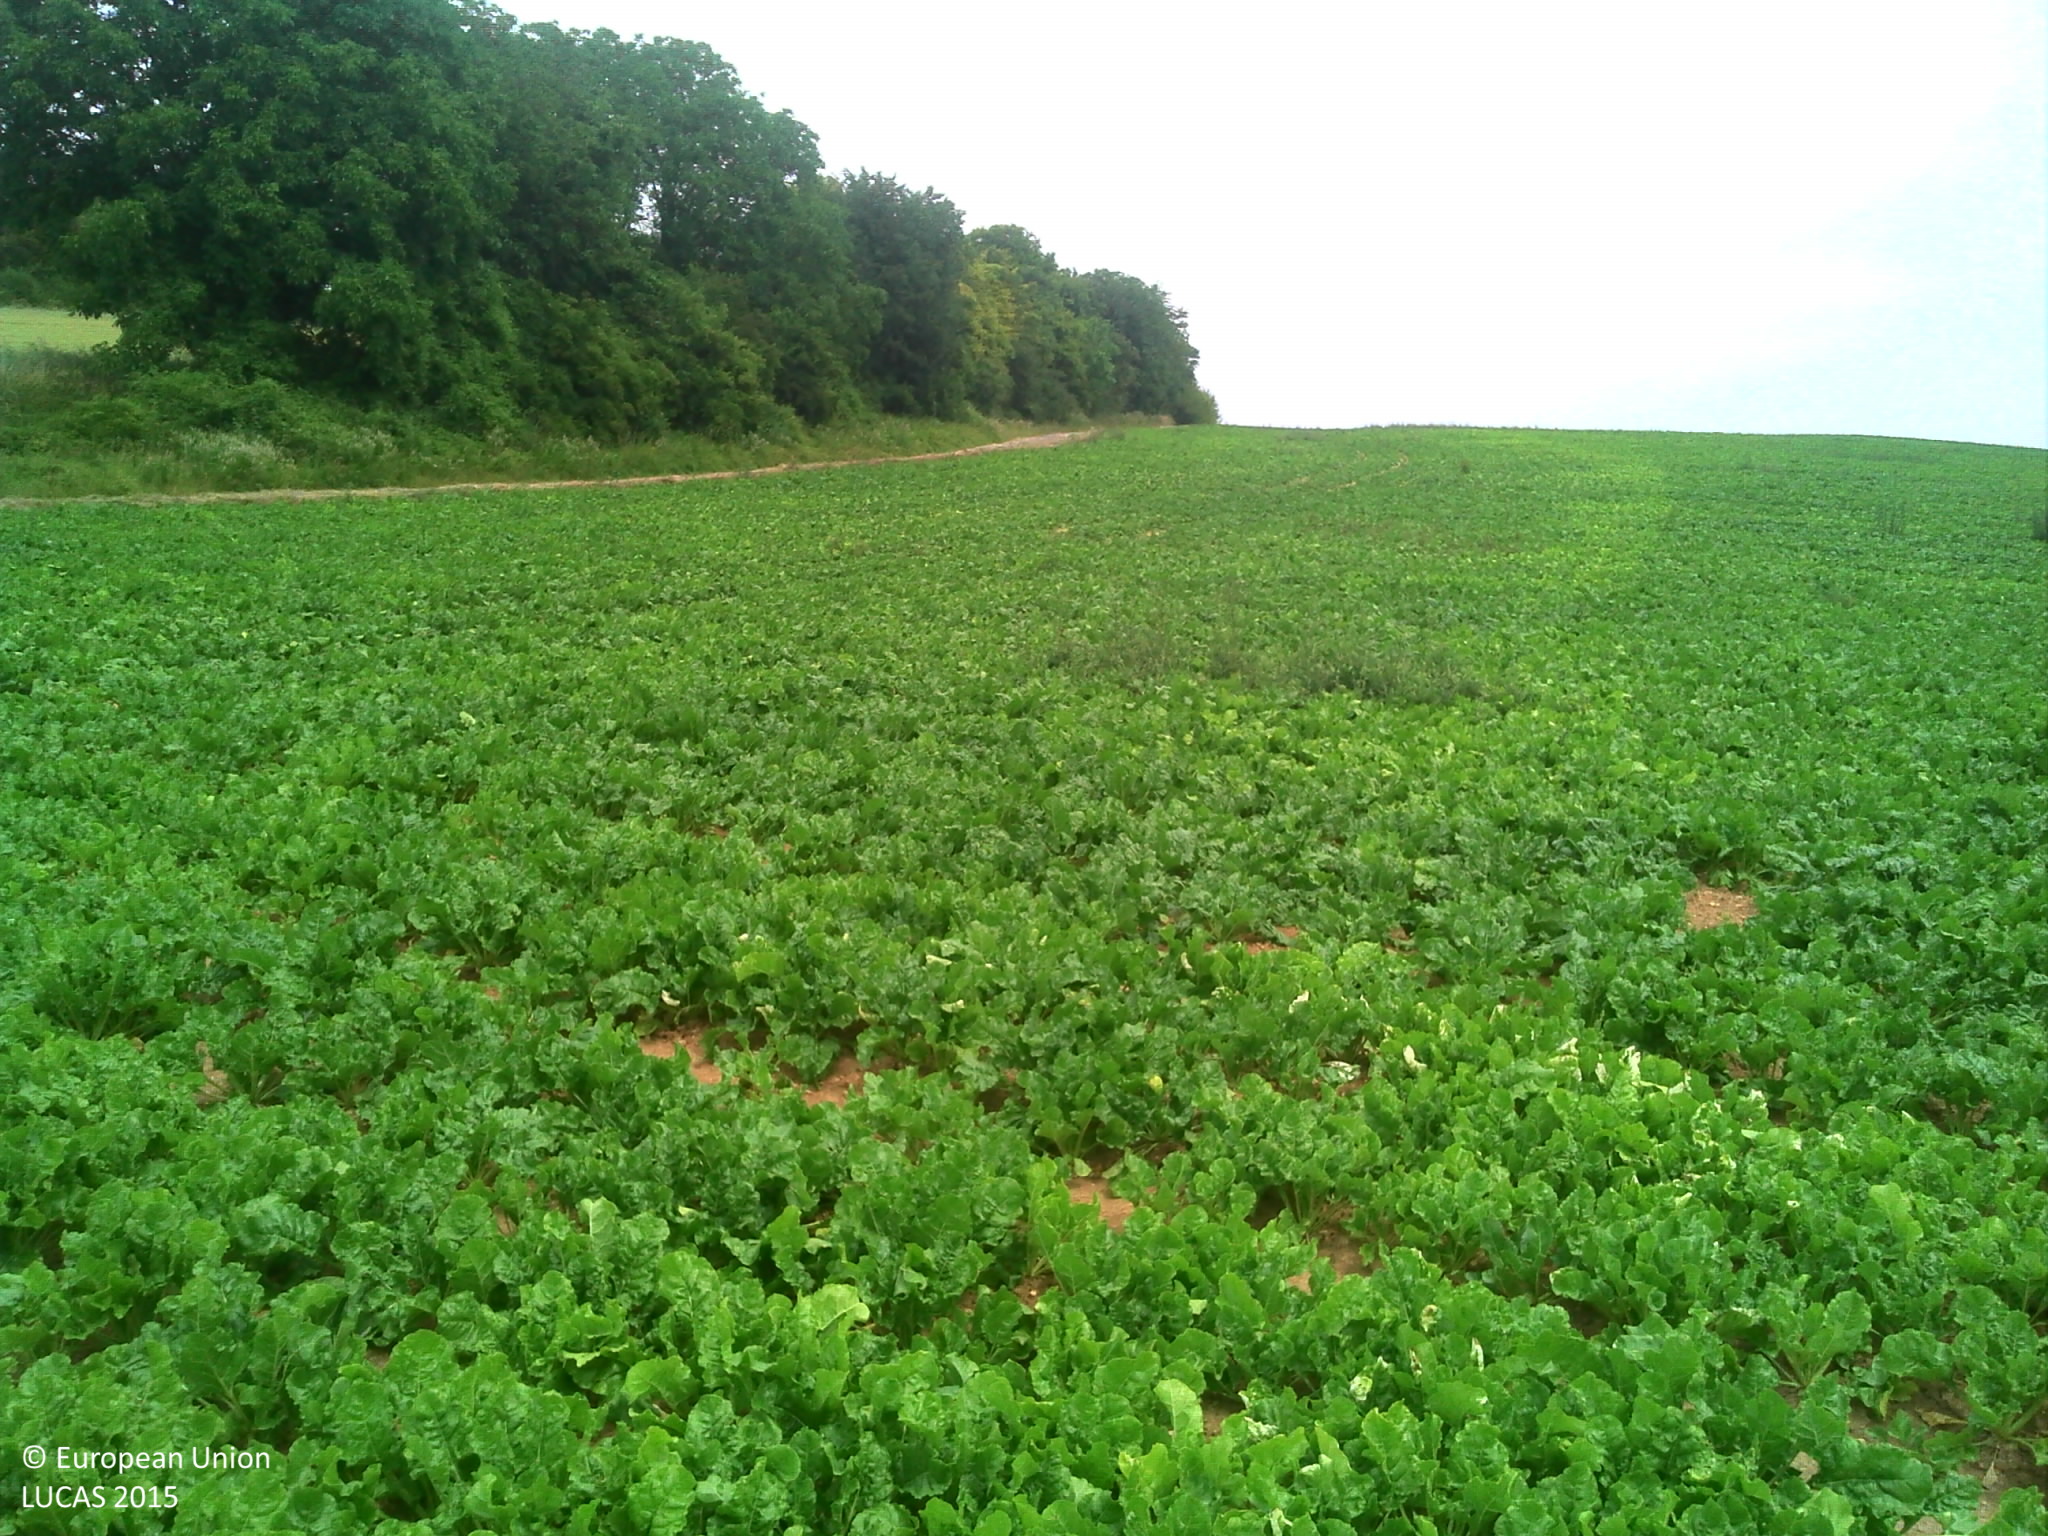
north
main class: Cropland
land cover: Sugar beet
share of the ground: > 75 %
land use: Agriculture (excluding fallow land and kitchen gardens)
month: June
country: FR
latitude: 49.4292
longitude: 3.6371
